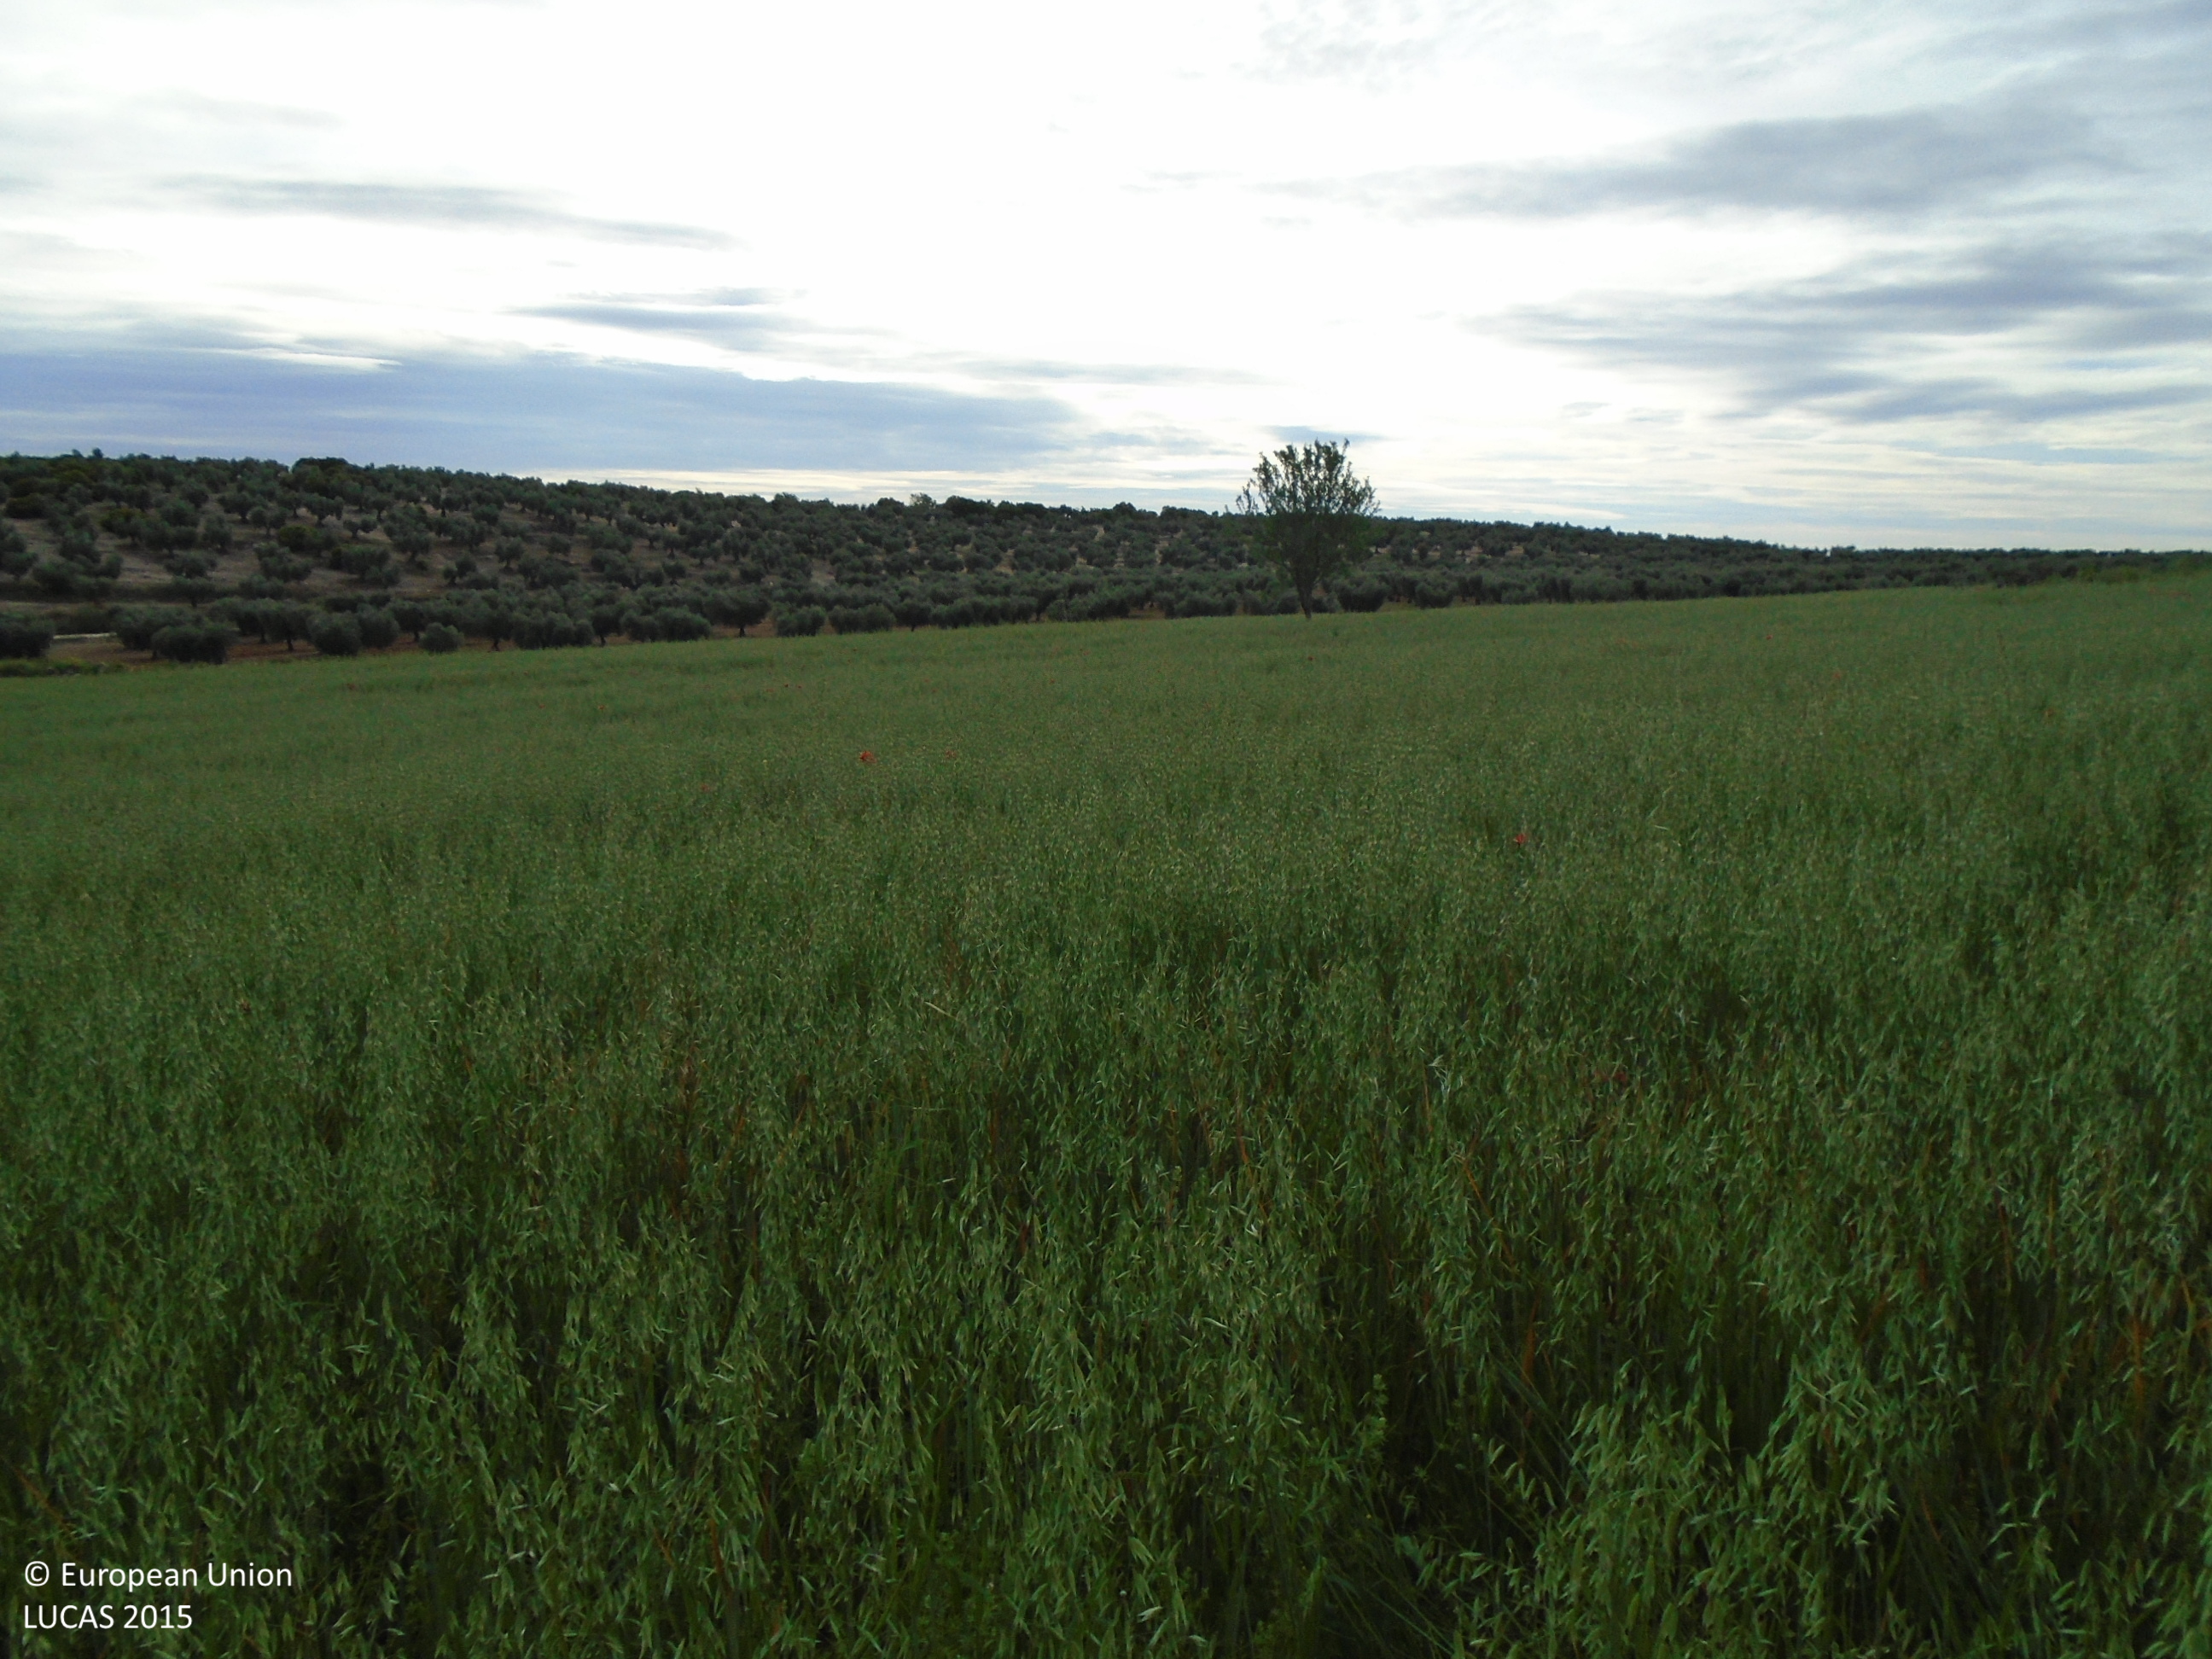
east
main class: Cropland
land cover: Oats
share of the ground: > 75 %
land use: Agriculture (excluding fallow land and kitchen gardens)
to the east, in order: Oats; Grass margins; Oats; Grass margins; Ditches and canals; Grass margins; Olive groves; Grass margins; Tracks
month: May
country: ES
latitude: 39.7176
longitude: -4.6108
